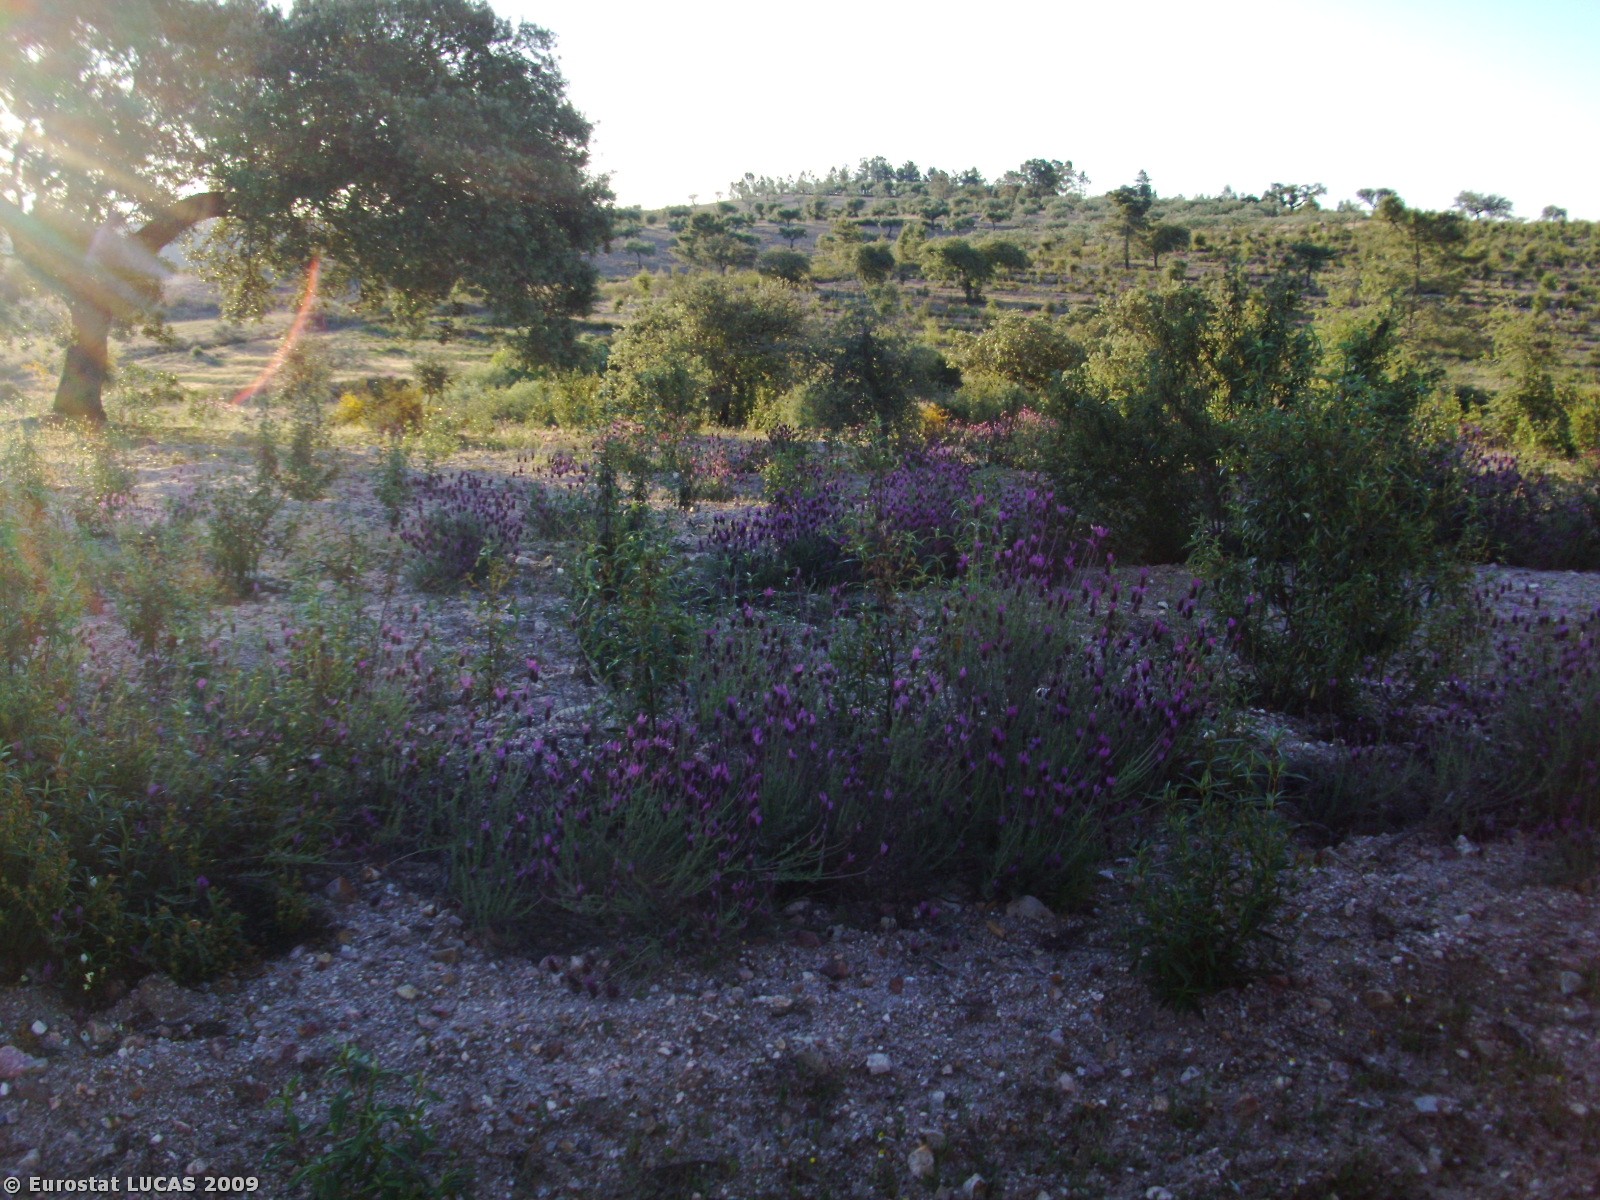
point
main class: Woodland
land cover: Broadleaved woodland
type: broadleaved evergreen forest
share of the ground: 10 - 25 %
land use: Forestry
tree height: > 5 m
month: May
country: PT
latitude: 39.7121
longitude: -7.5125
